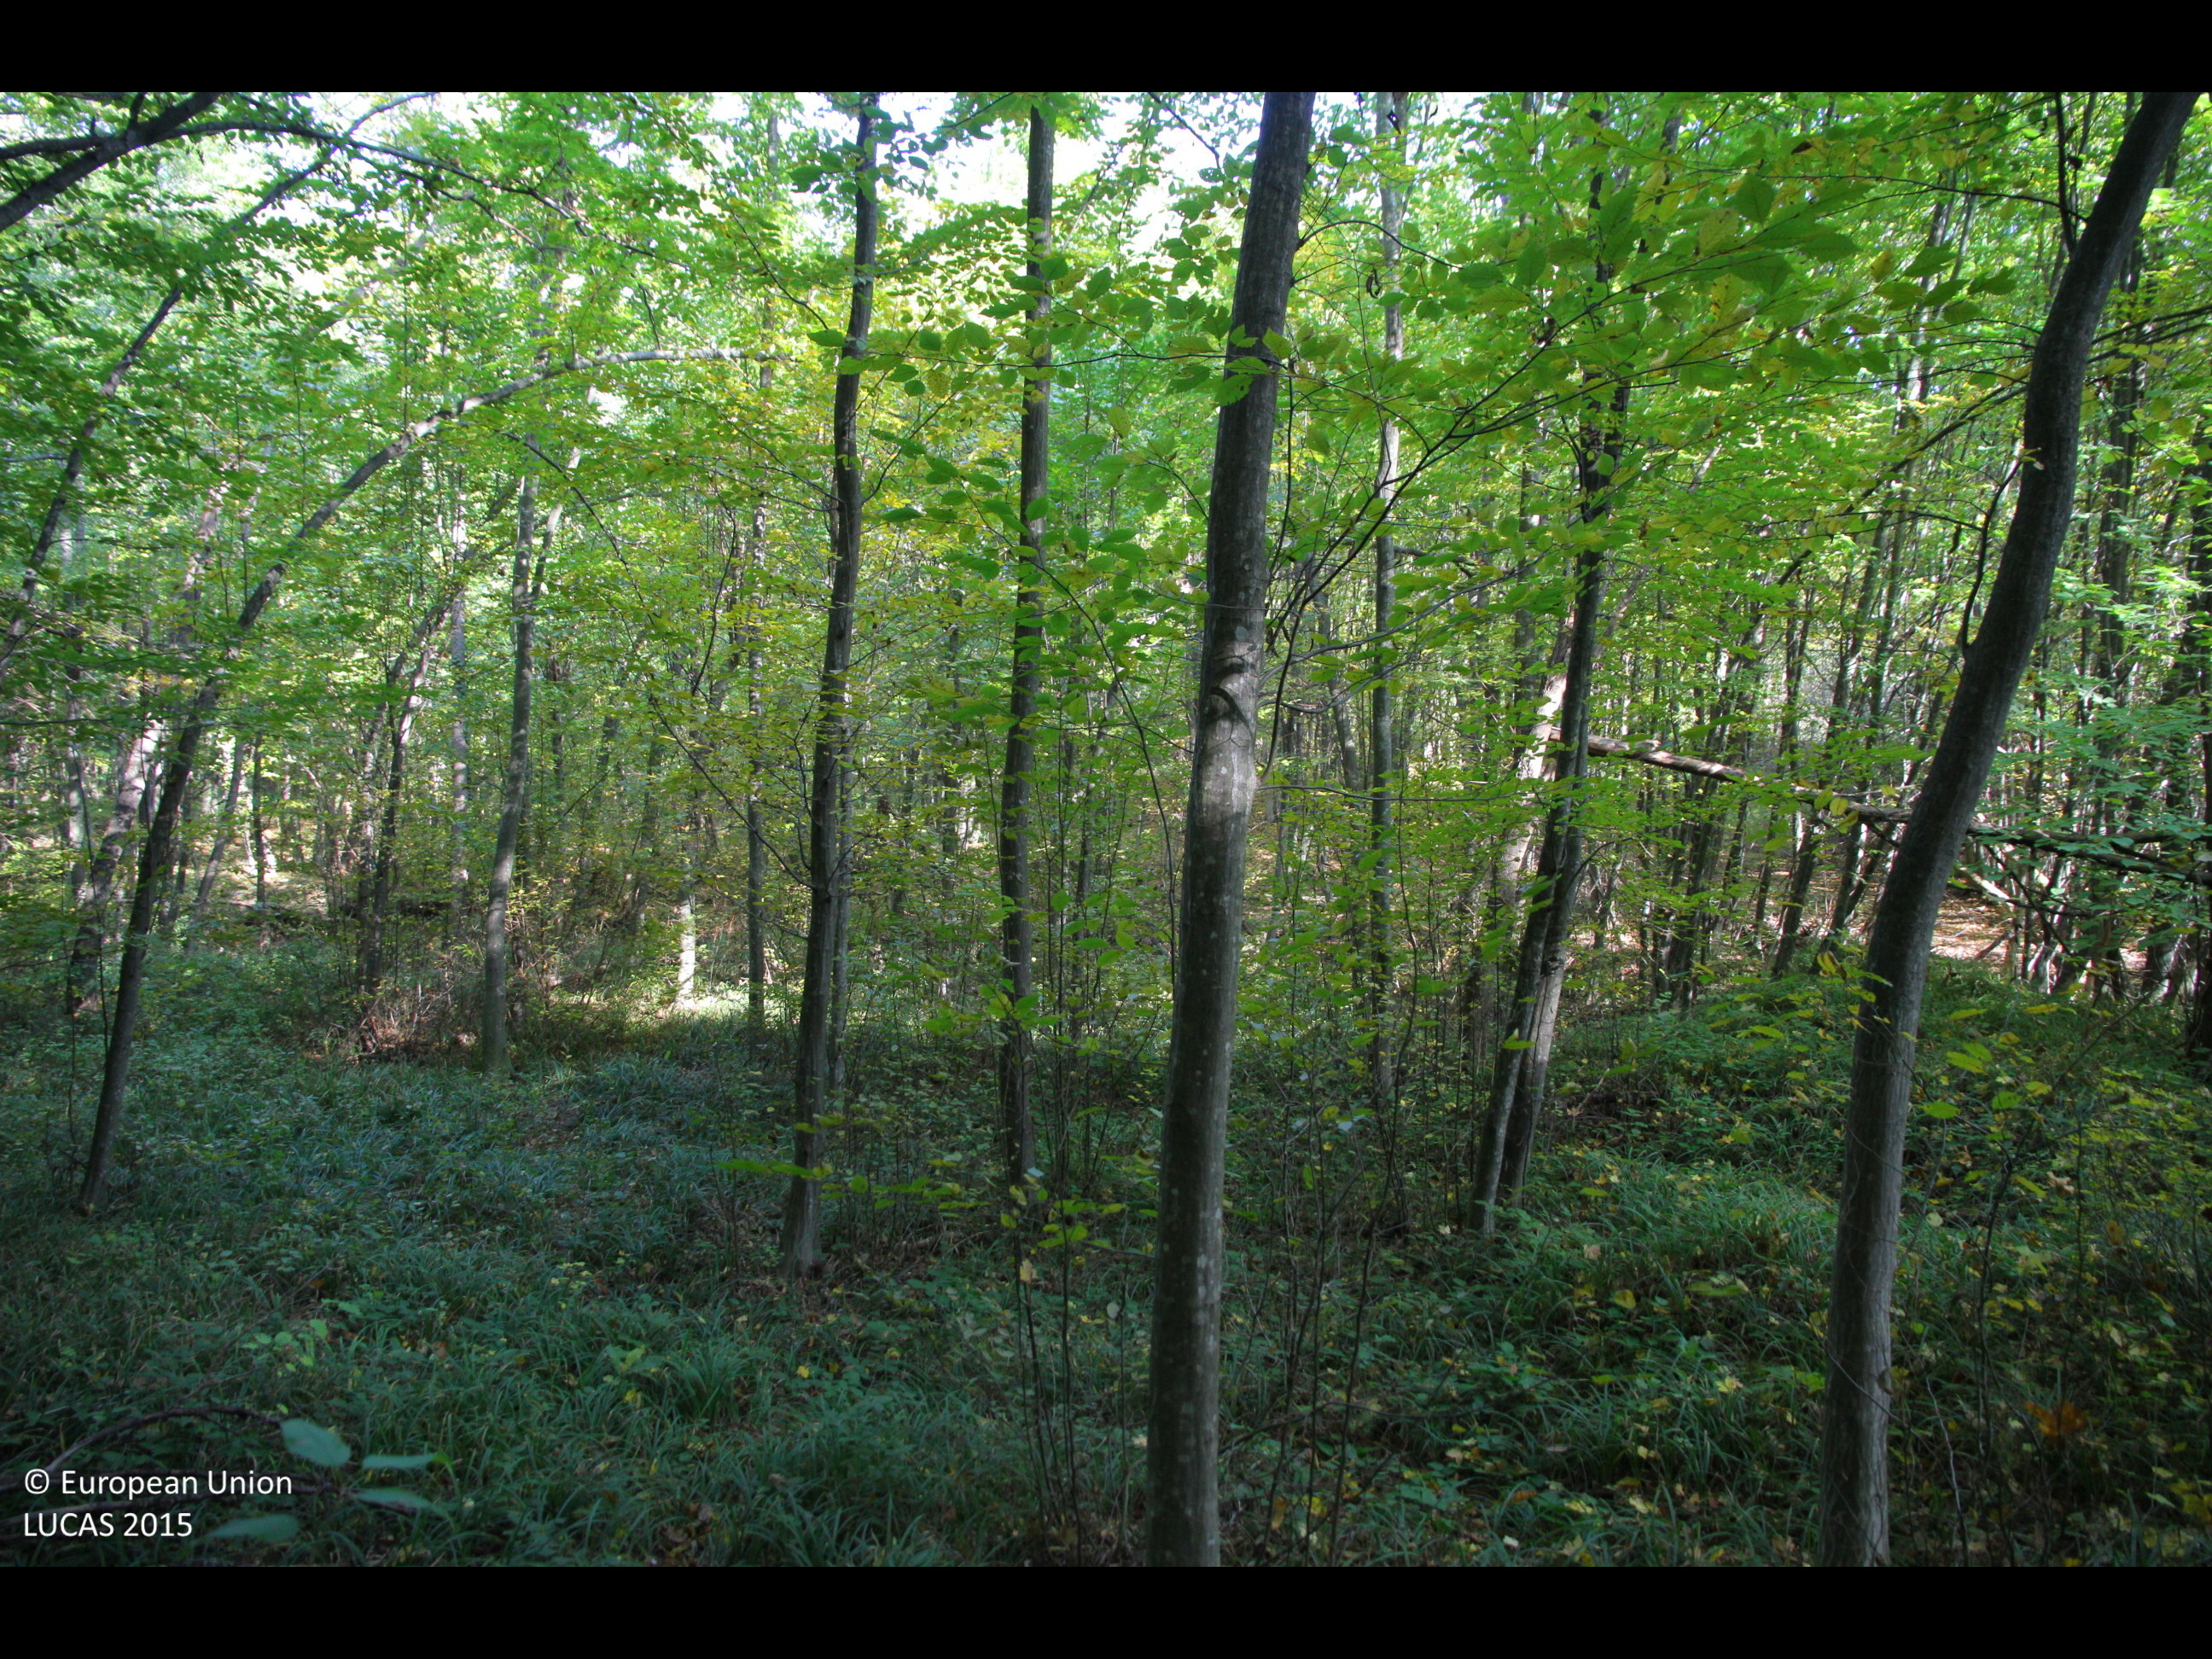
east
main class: Woodland
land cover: Broadleaved woodland
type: beech forest
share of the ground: > 75 %
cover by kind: broadleaved forest trees 100 %
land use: Forestry
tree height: > 5 m
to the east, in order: Broadleaved woodland; Rivers and streams; Broadleaved woodland; Paved roads, cycling and walking lanes; Broadleaved woodland; Rivers and streams; Broadleaved woodland
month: October
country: BG
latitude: 42.9756
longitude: 26.8695
